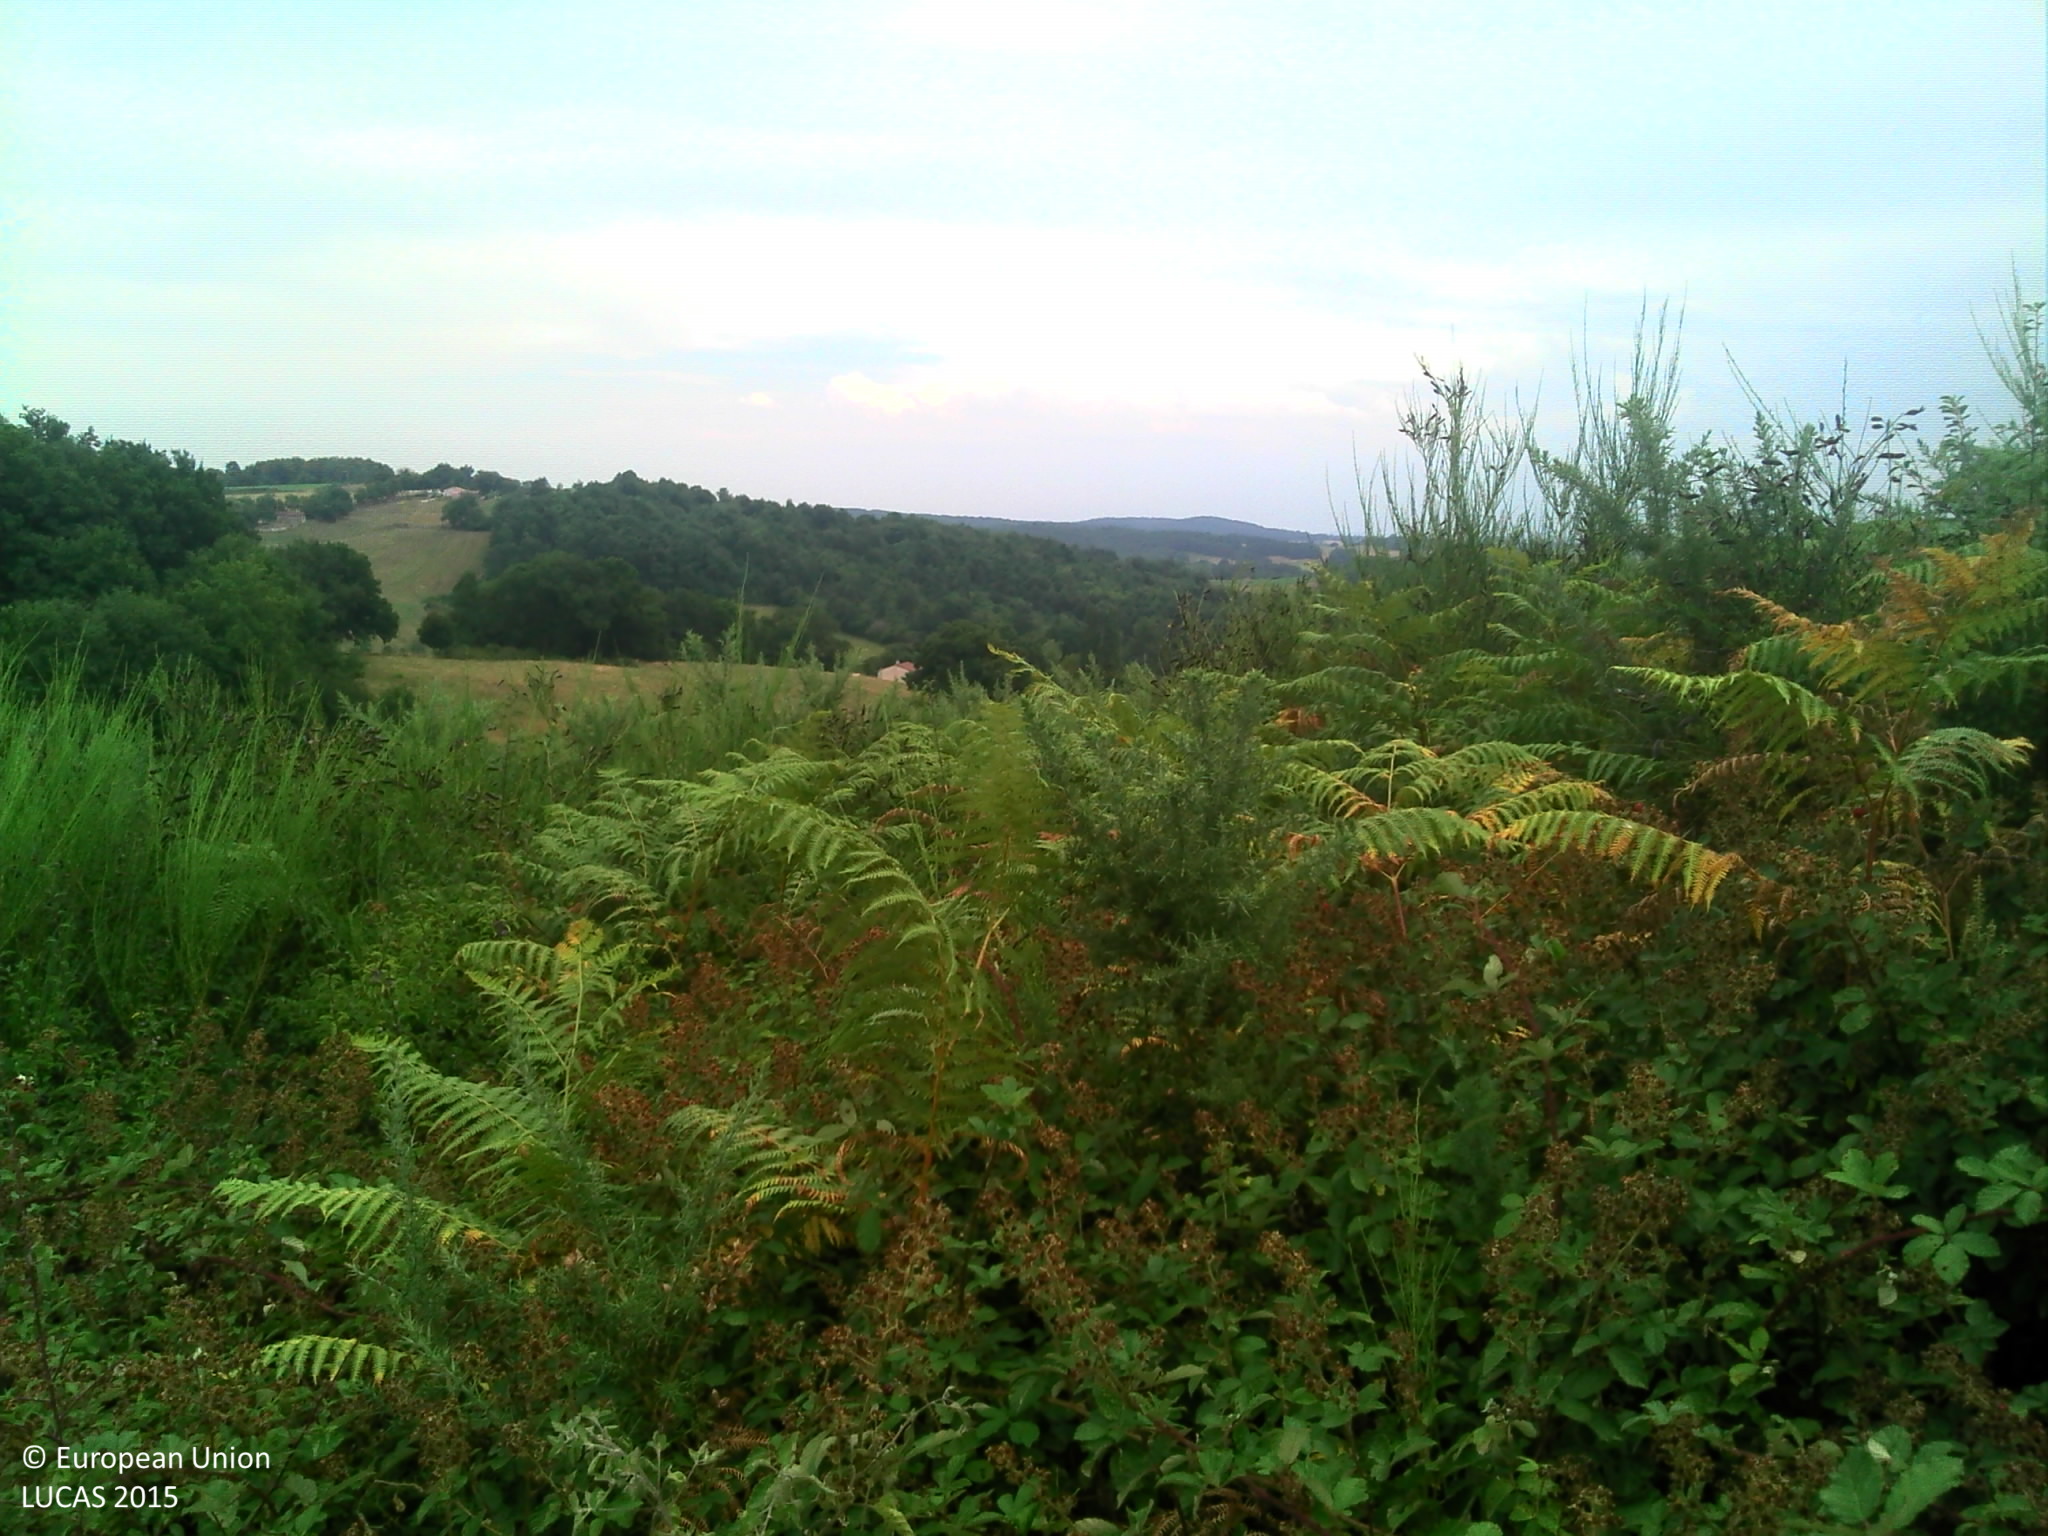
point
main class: Shrubland
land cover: Shrubland without tree cover
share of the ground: > 75 %
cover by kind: shrubs 100 %
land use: Semi-natural and natural areas not in use
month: July
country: FR
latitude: 43.1755
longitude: 0.7630
